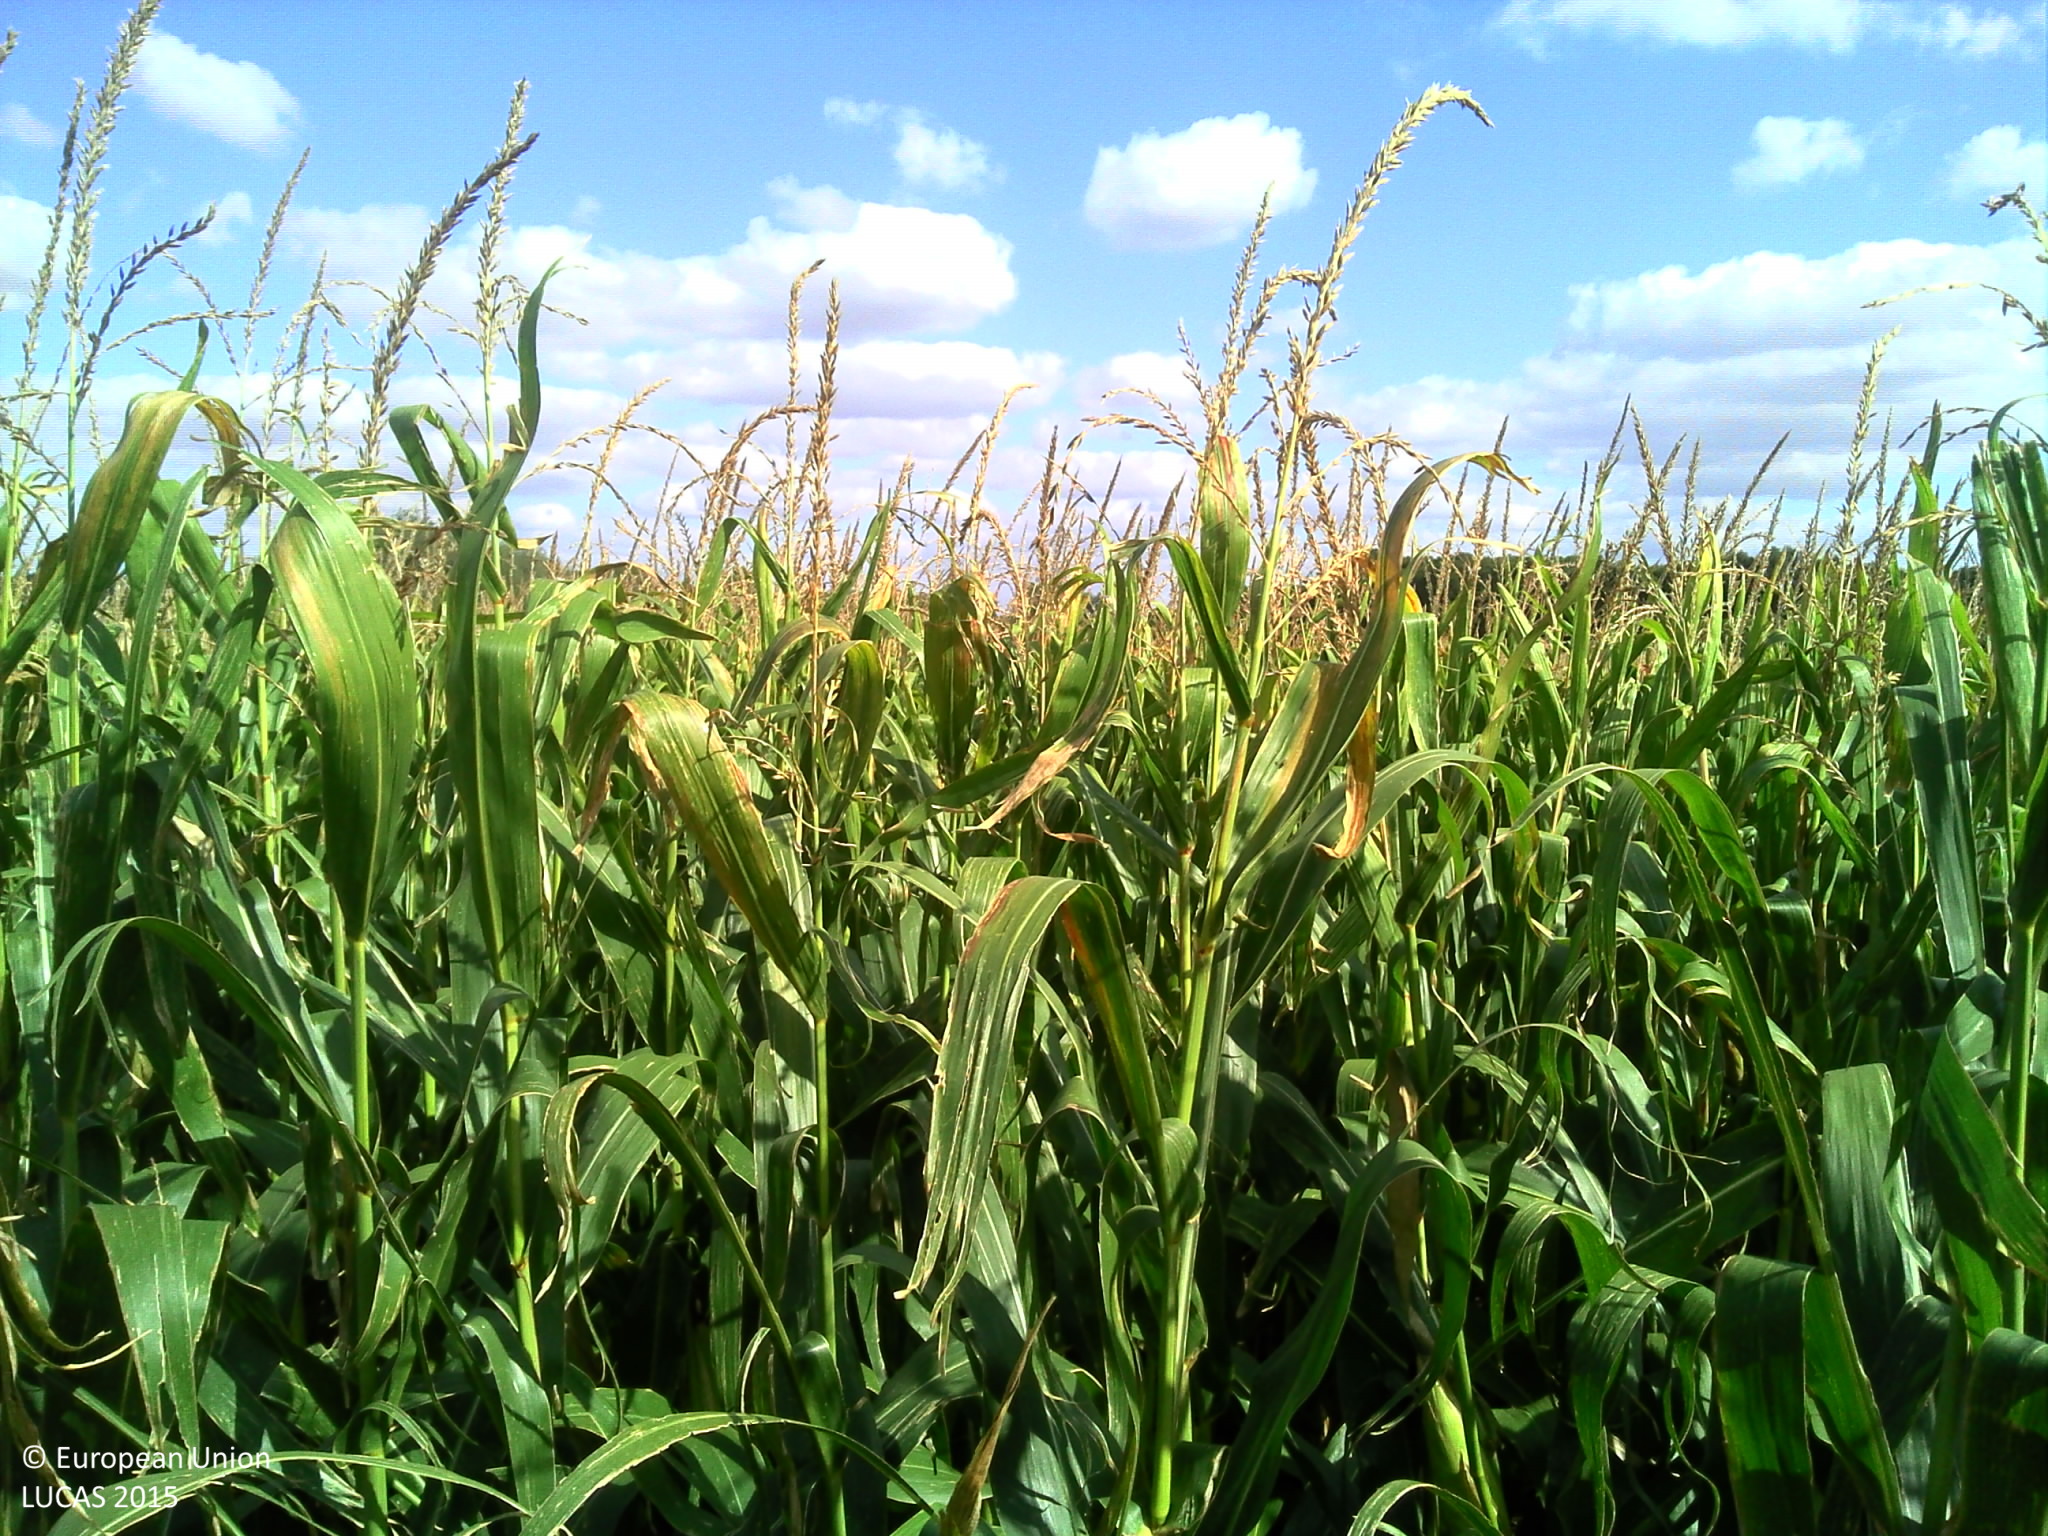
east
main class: Cropland
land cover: Maize
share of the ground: > 75 %
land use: Agriculture (excluding fallow land and kitchen gardens)
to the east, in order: Maize
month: September
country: FR
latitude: 46.9272
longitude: 1.6230
